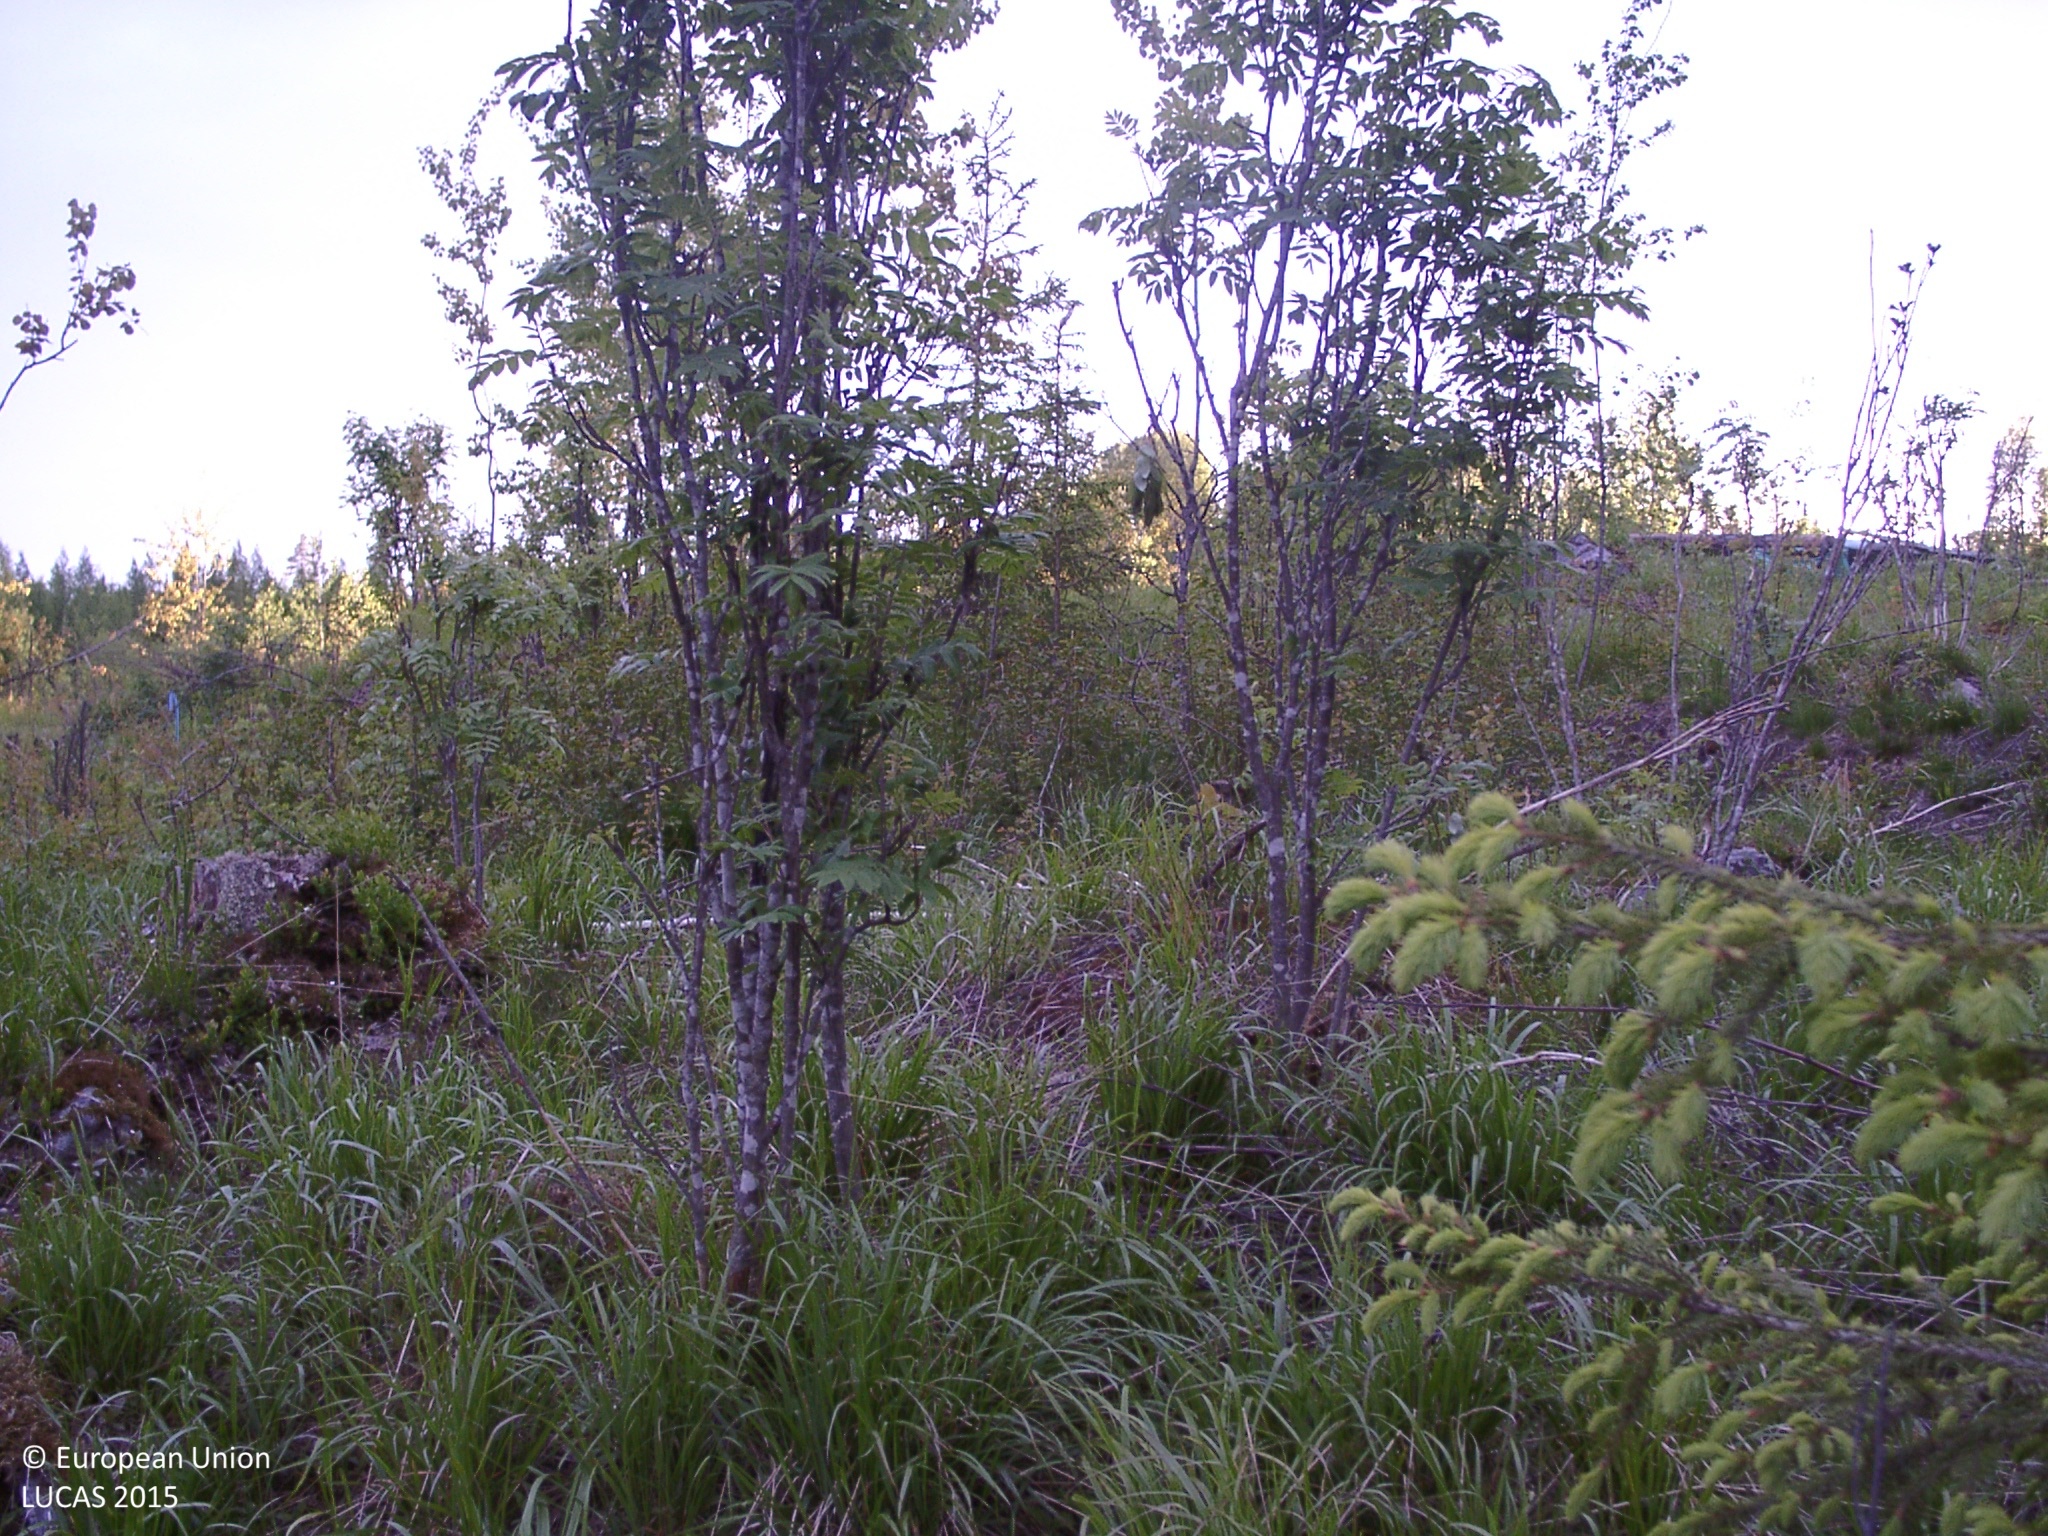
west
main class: Woodland
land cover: Broadleaved woodland
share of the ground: 10 - 25 %
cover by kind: herbaceous plants 80 %, broadleaved forest trees 20 %
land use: Forestry
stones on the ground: < 10 %
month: June
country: FI
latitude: 62.0858
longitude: 25.6089
